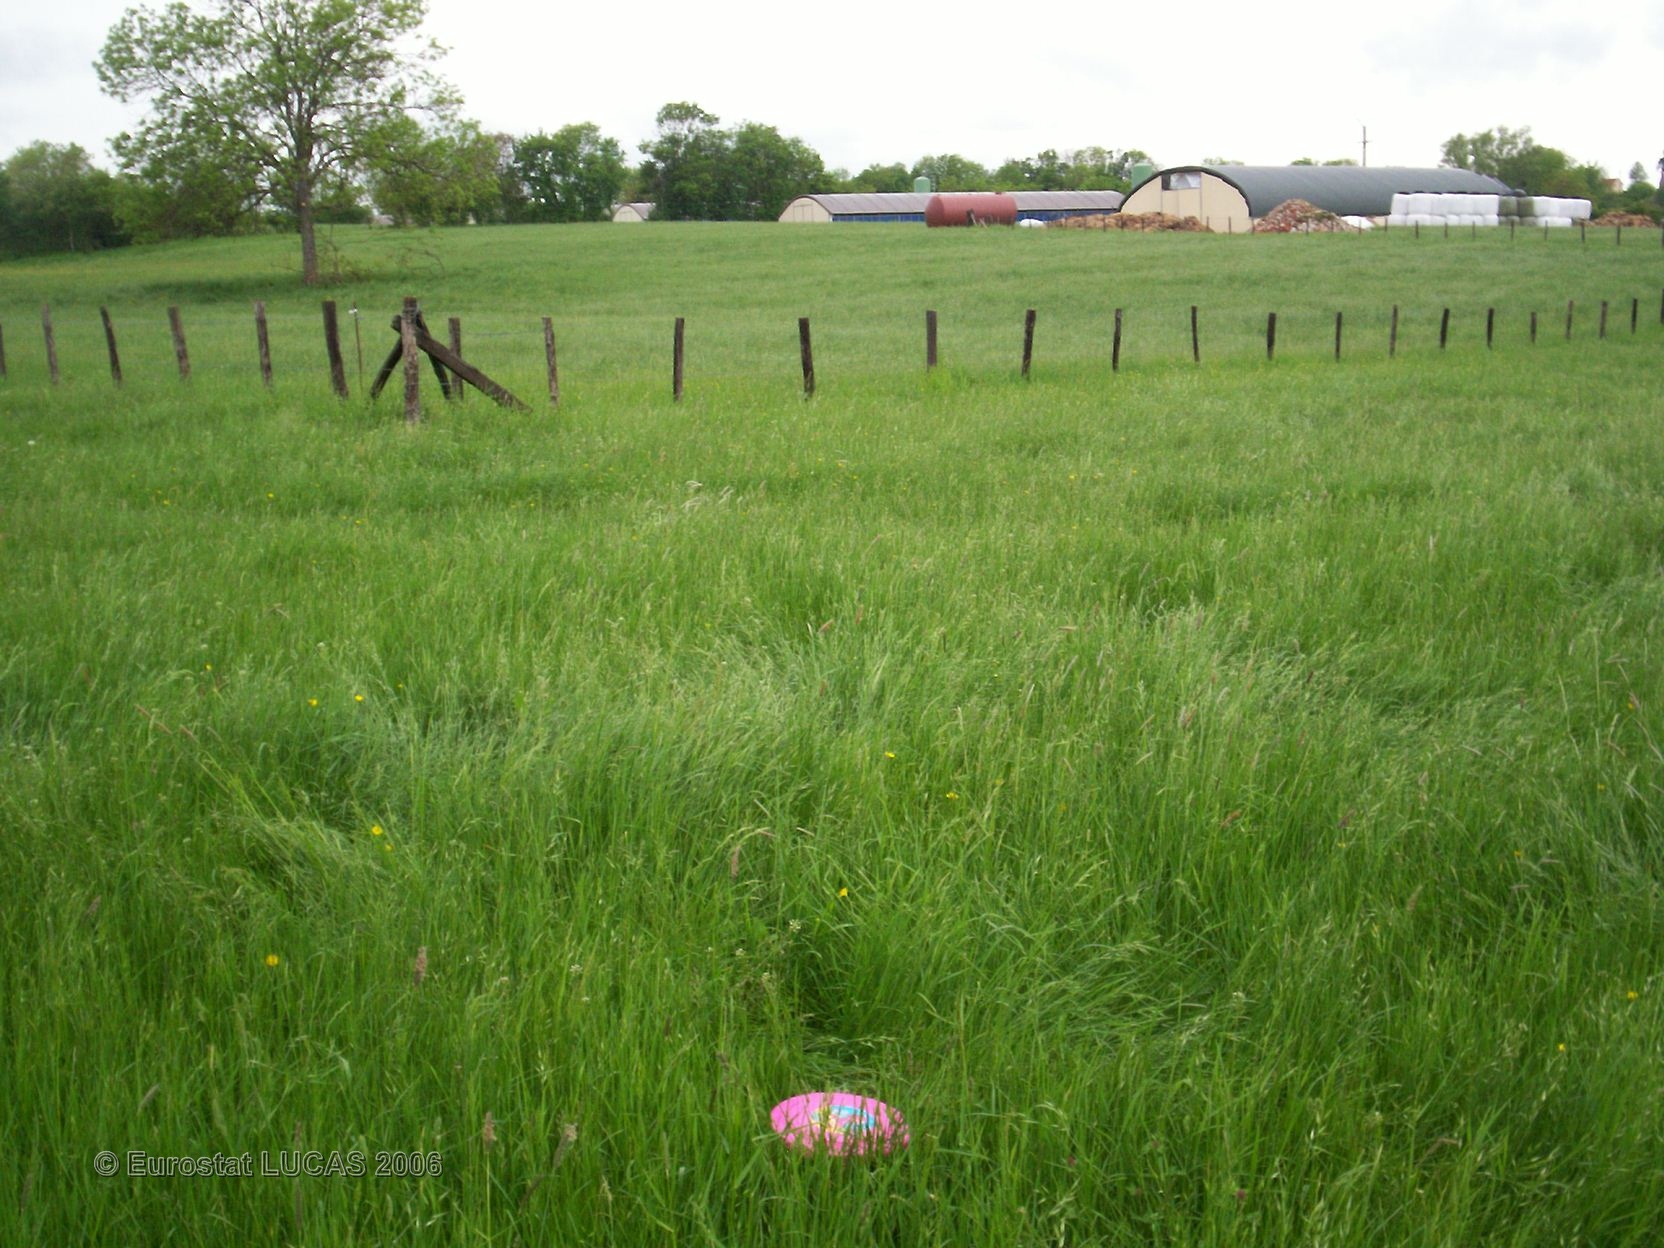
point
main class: Grassland
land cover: Grassland without tree/shrub cover
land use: Agriculture (excluding fallow land and kitchen gardens)
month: May
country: FR
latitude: 47.2061
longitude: 4.5739
